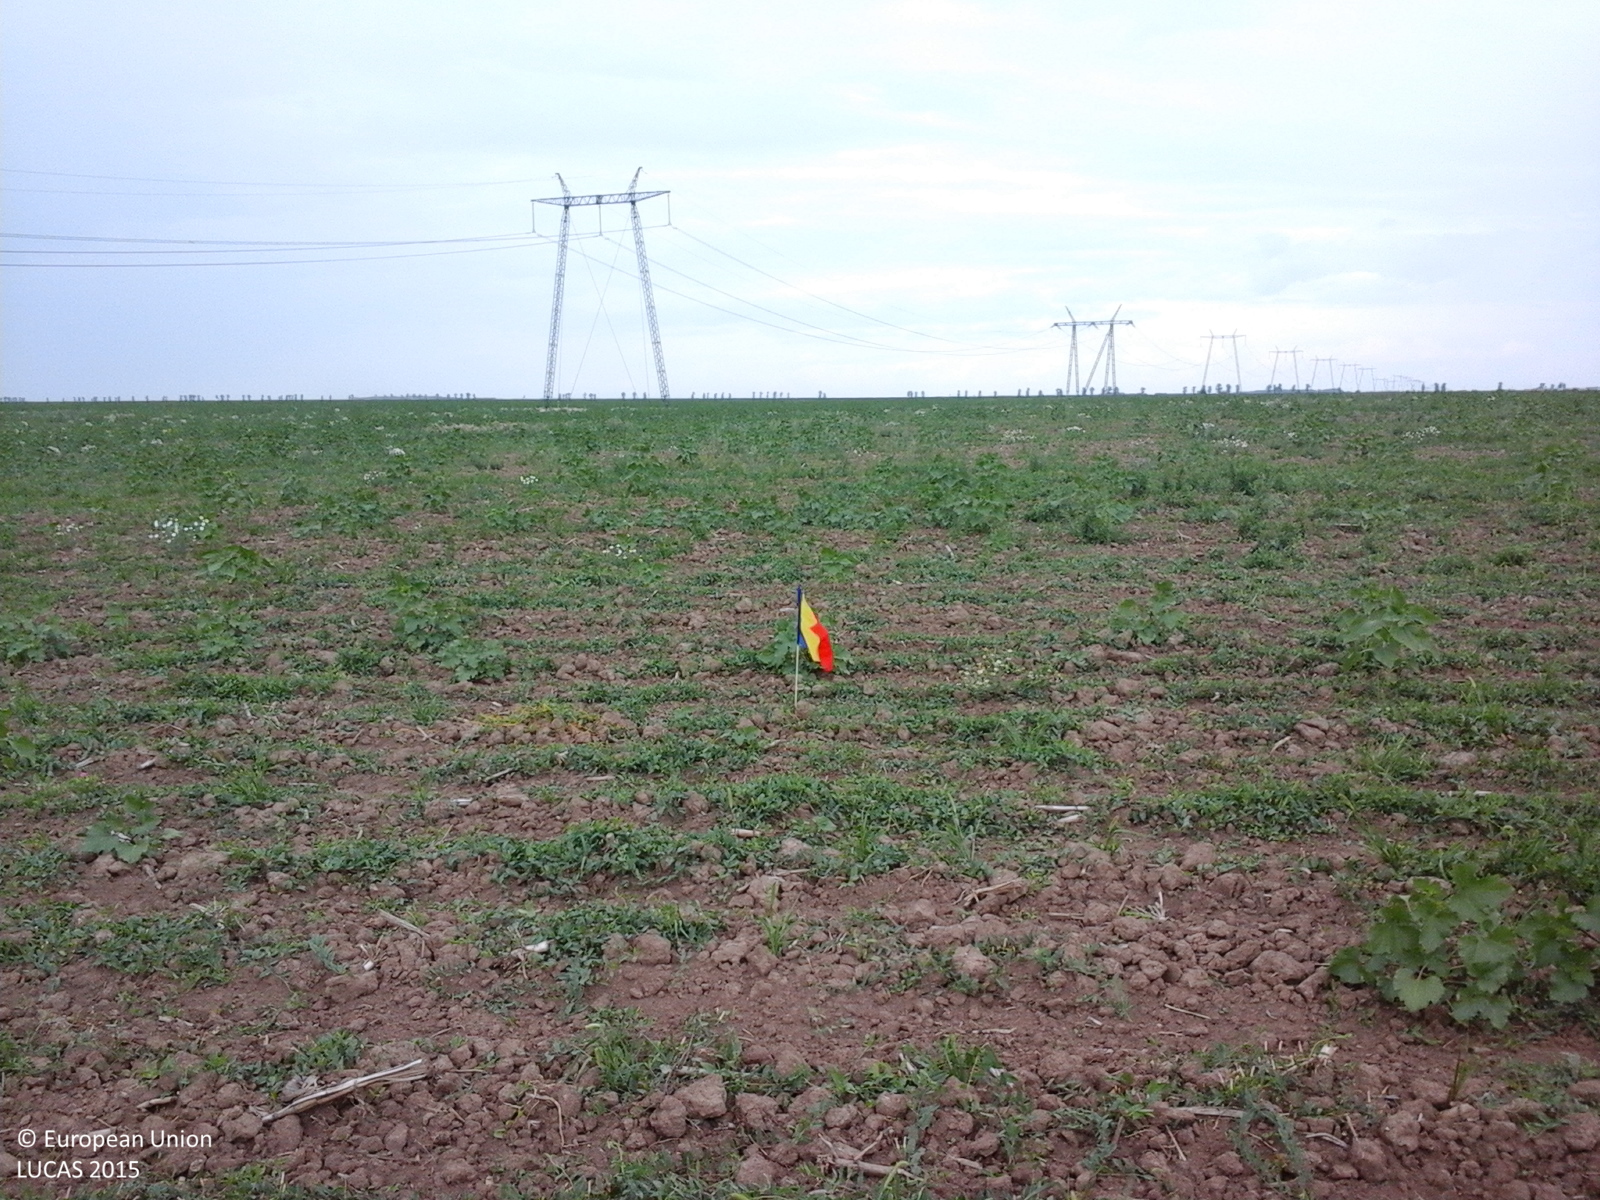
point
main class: Grassland
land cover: Spontaneously vegetated surfaces
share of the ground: 25 - 50 %
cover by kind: herbaceous plants 100 %
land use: Fallow land
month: July
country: RO
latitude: 44.3000
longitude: 24.8540
